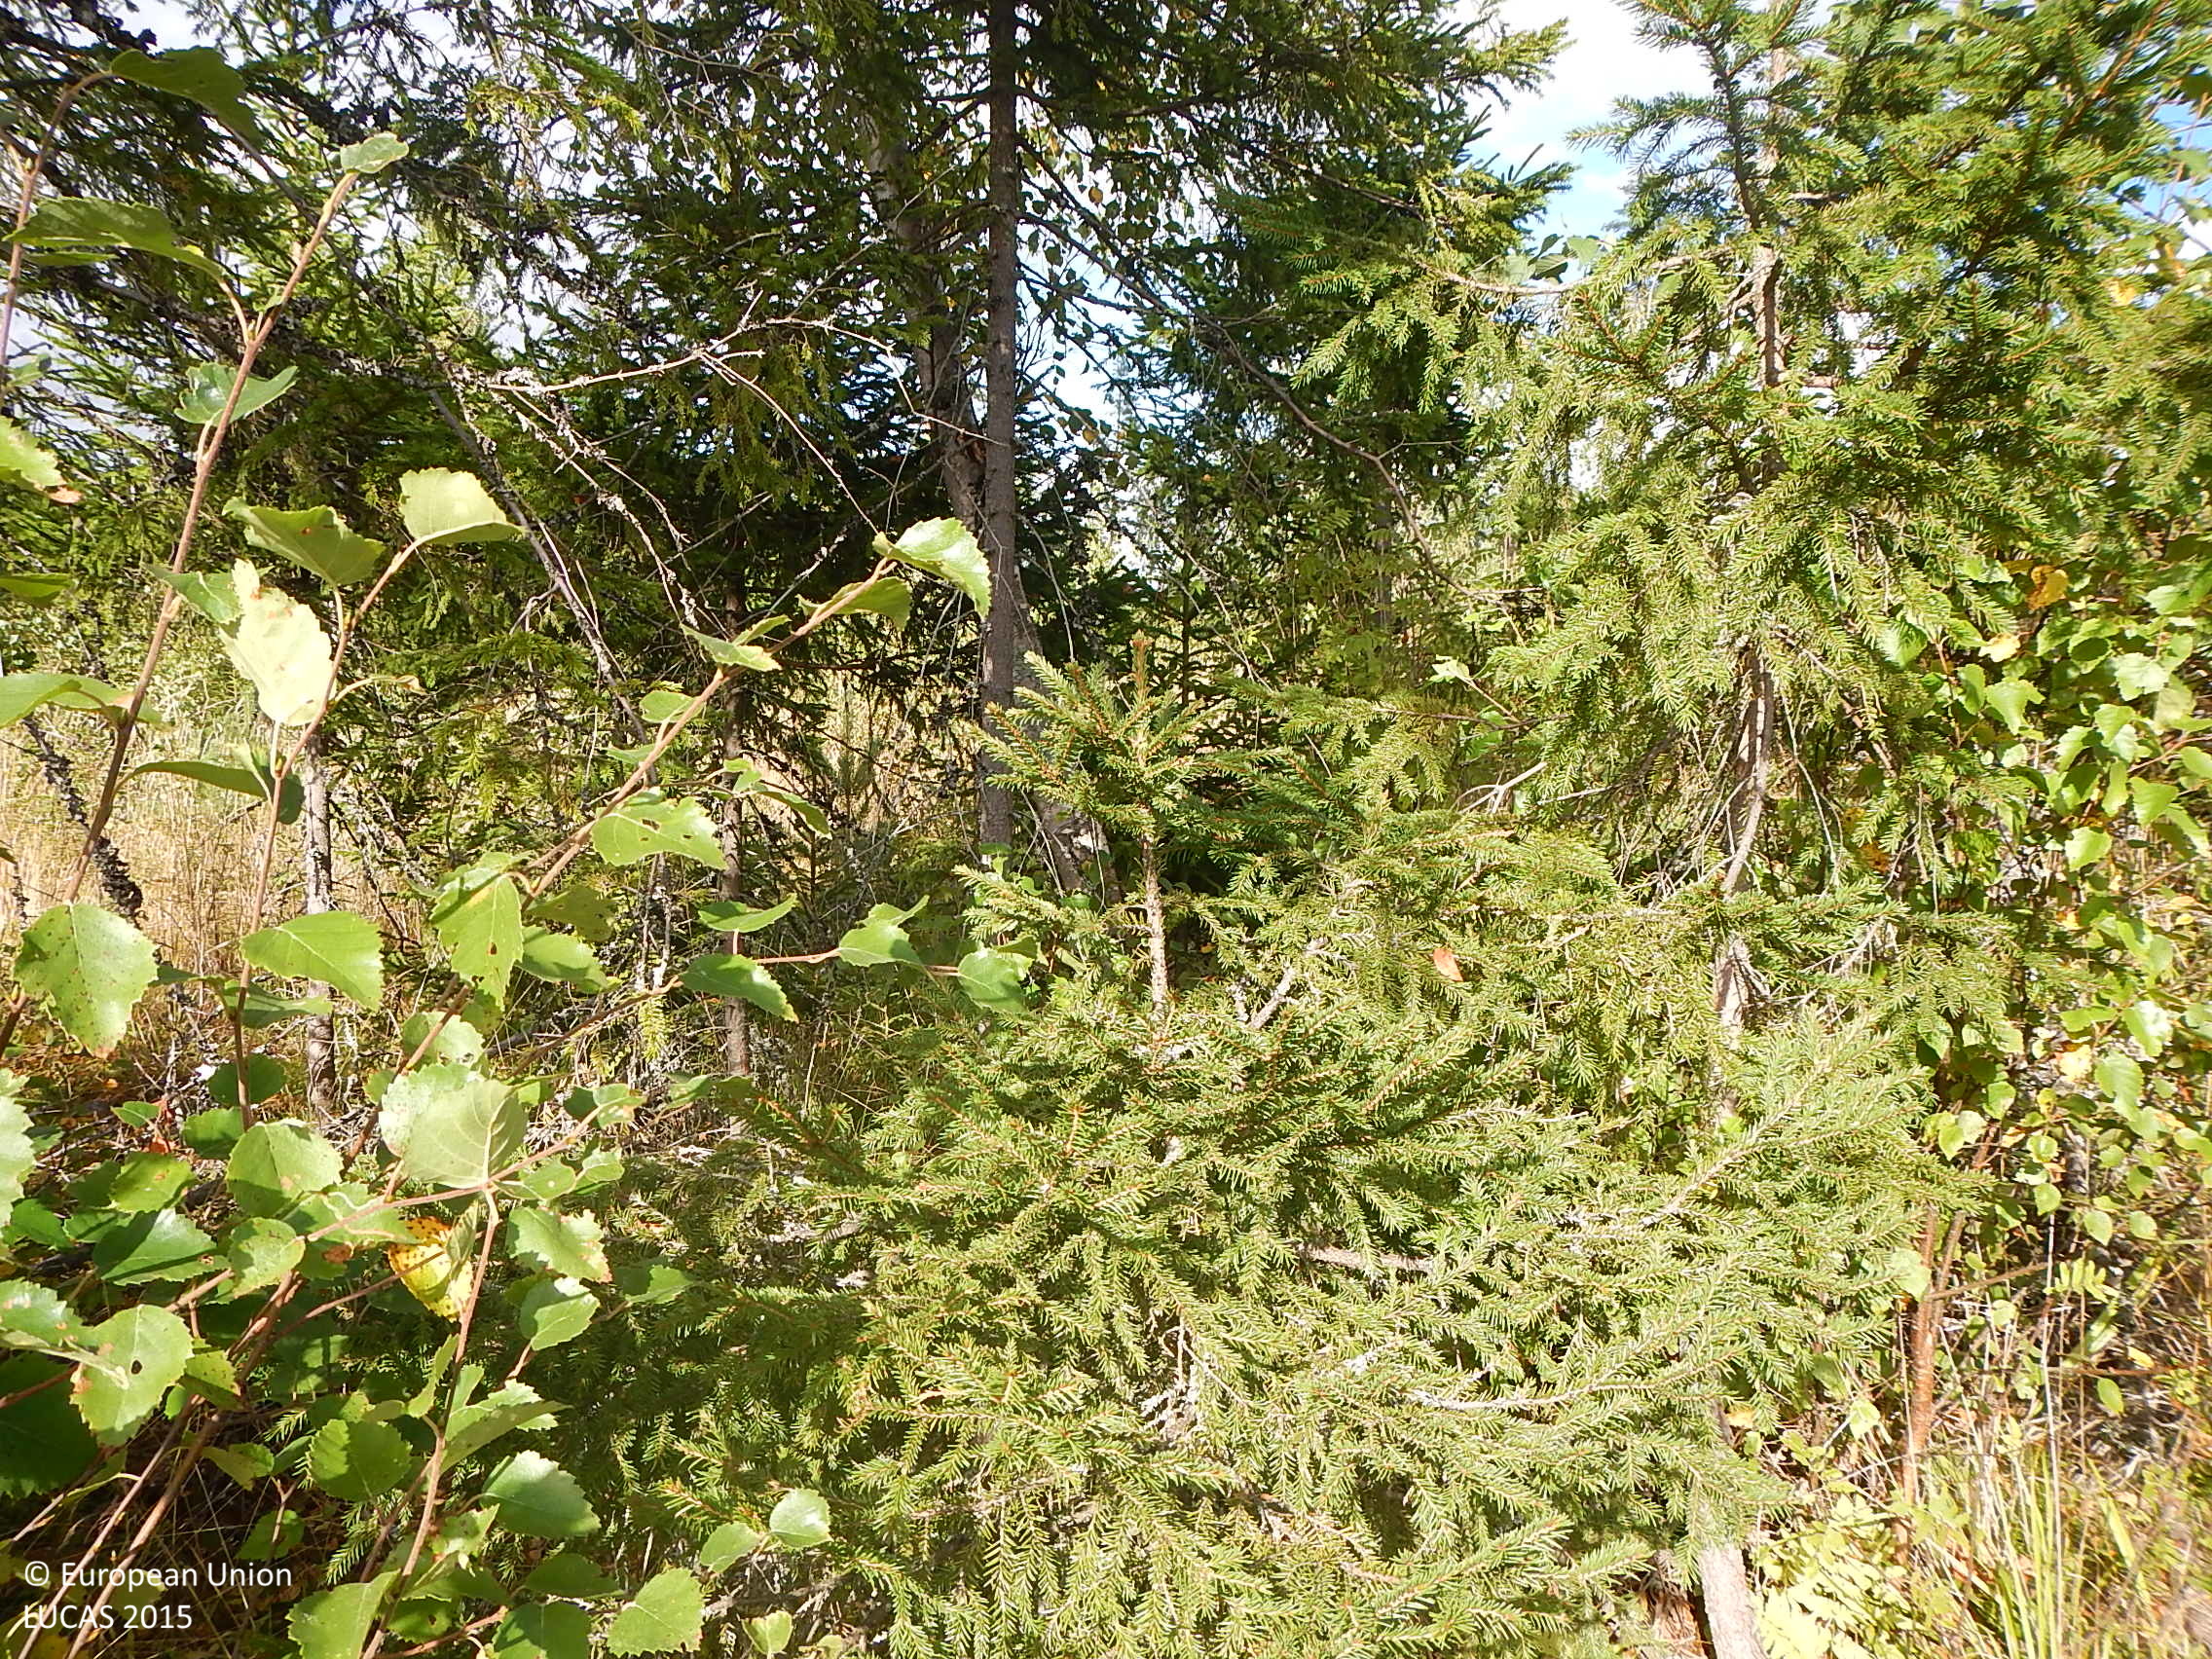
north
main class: Woodland
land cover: Other mixed woodland
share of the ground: 50 - 75 %
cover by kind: coniferous forest trees 25 %, broadleaved forest trees 25 %, shrubs 25 %, herbaceous plants 20 %, lichens and mosses 5 %
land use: Forestry
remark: Nursery
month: September
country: FI
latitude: 61.5072
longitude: 22.0268
